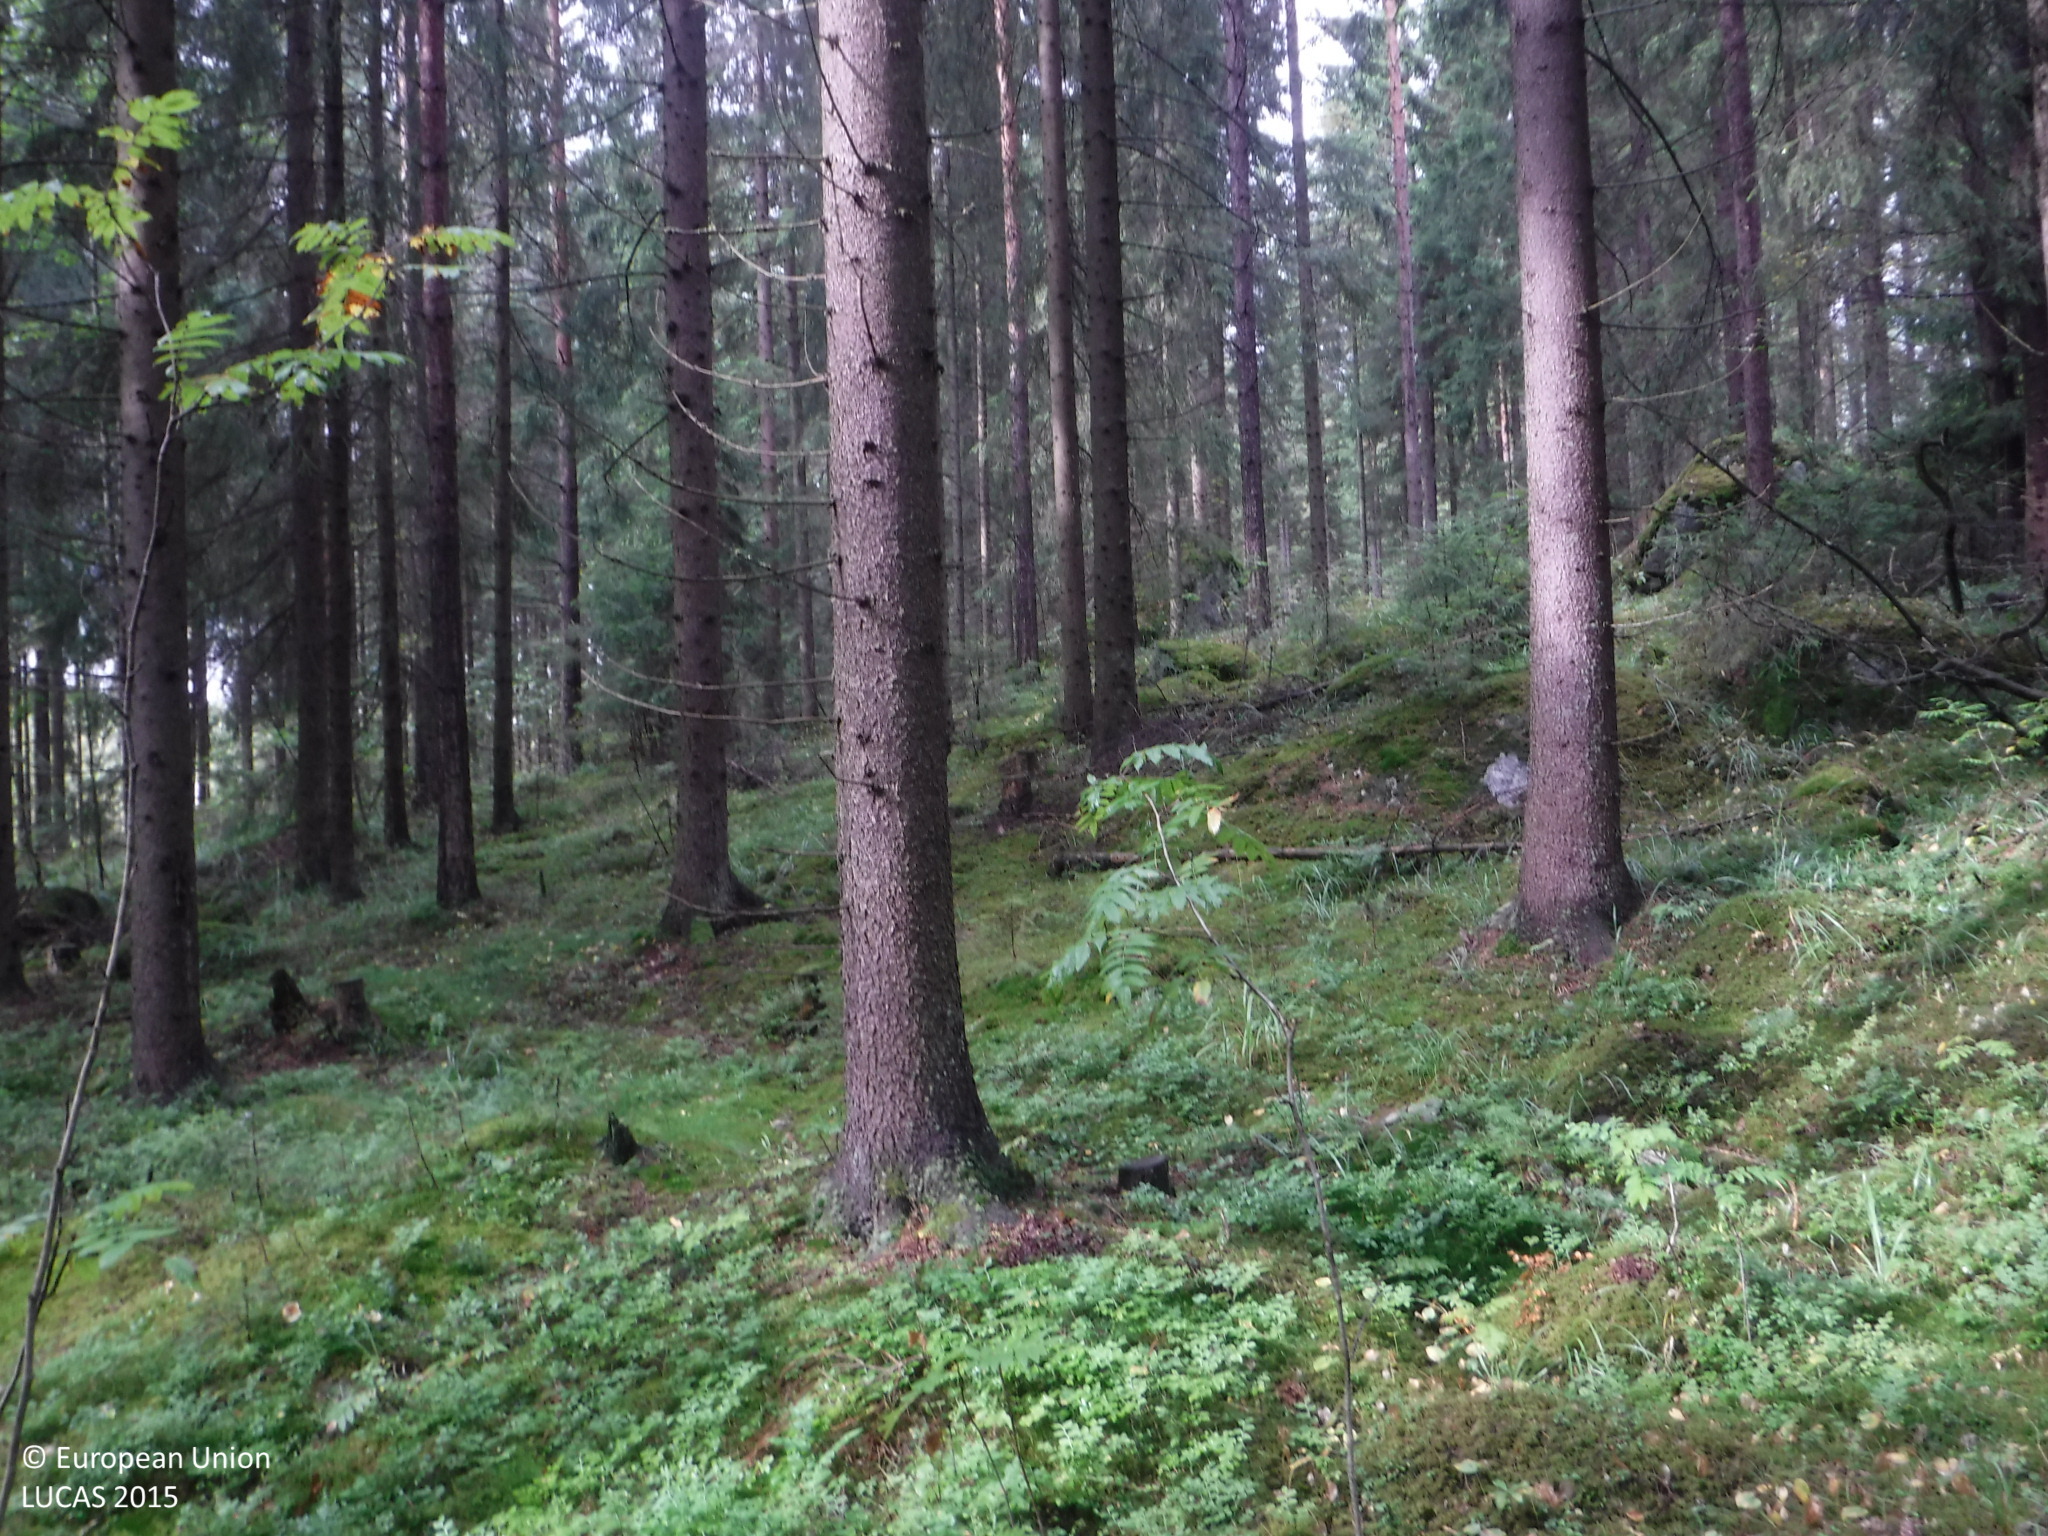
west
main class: Woodland
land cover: Spruce dominated coniferous woodland
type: boreal forest
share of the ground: 50 - 75 %
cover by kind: coniferous forest trees 60 %, lichens and mosses 25 %, shrubs 15 %
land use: Forestry
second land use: Agriculture (excluding fallow land and kitchen gardens)
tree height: > 5 m
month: September
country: FI
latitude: 61.2921
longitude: 23.2334
